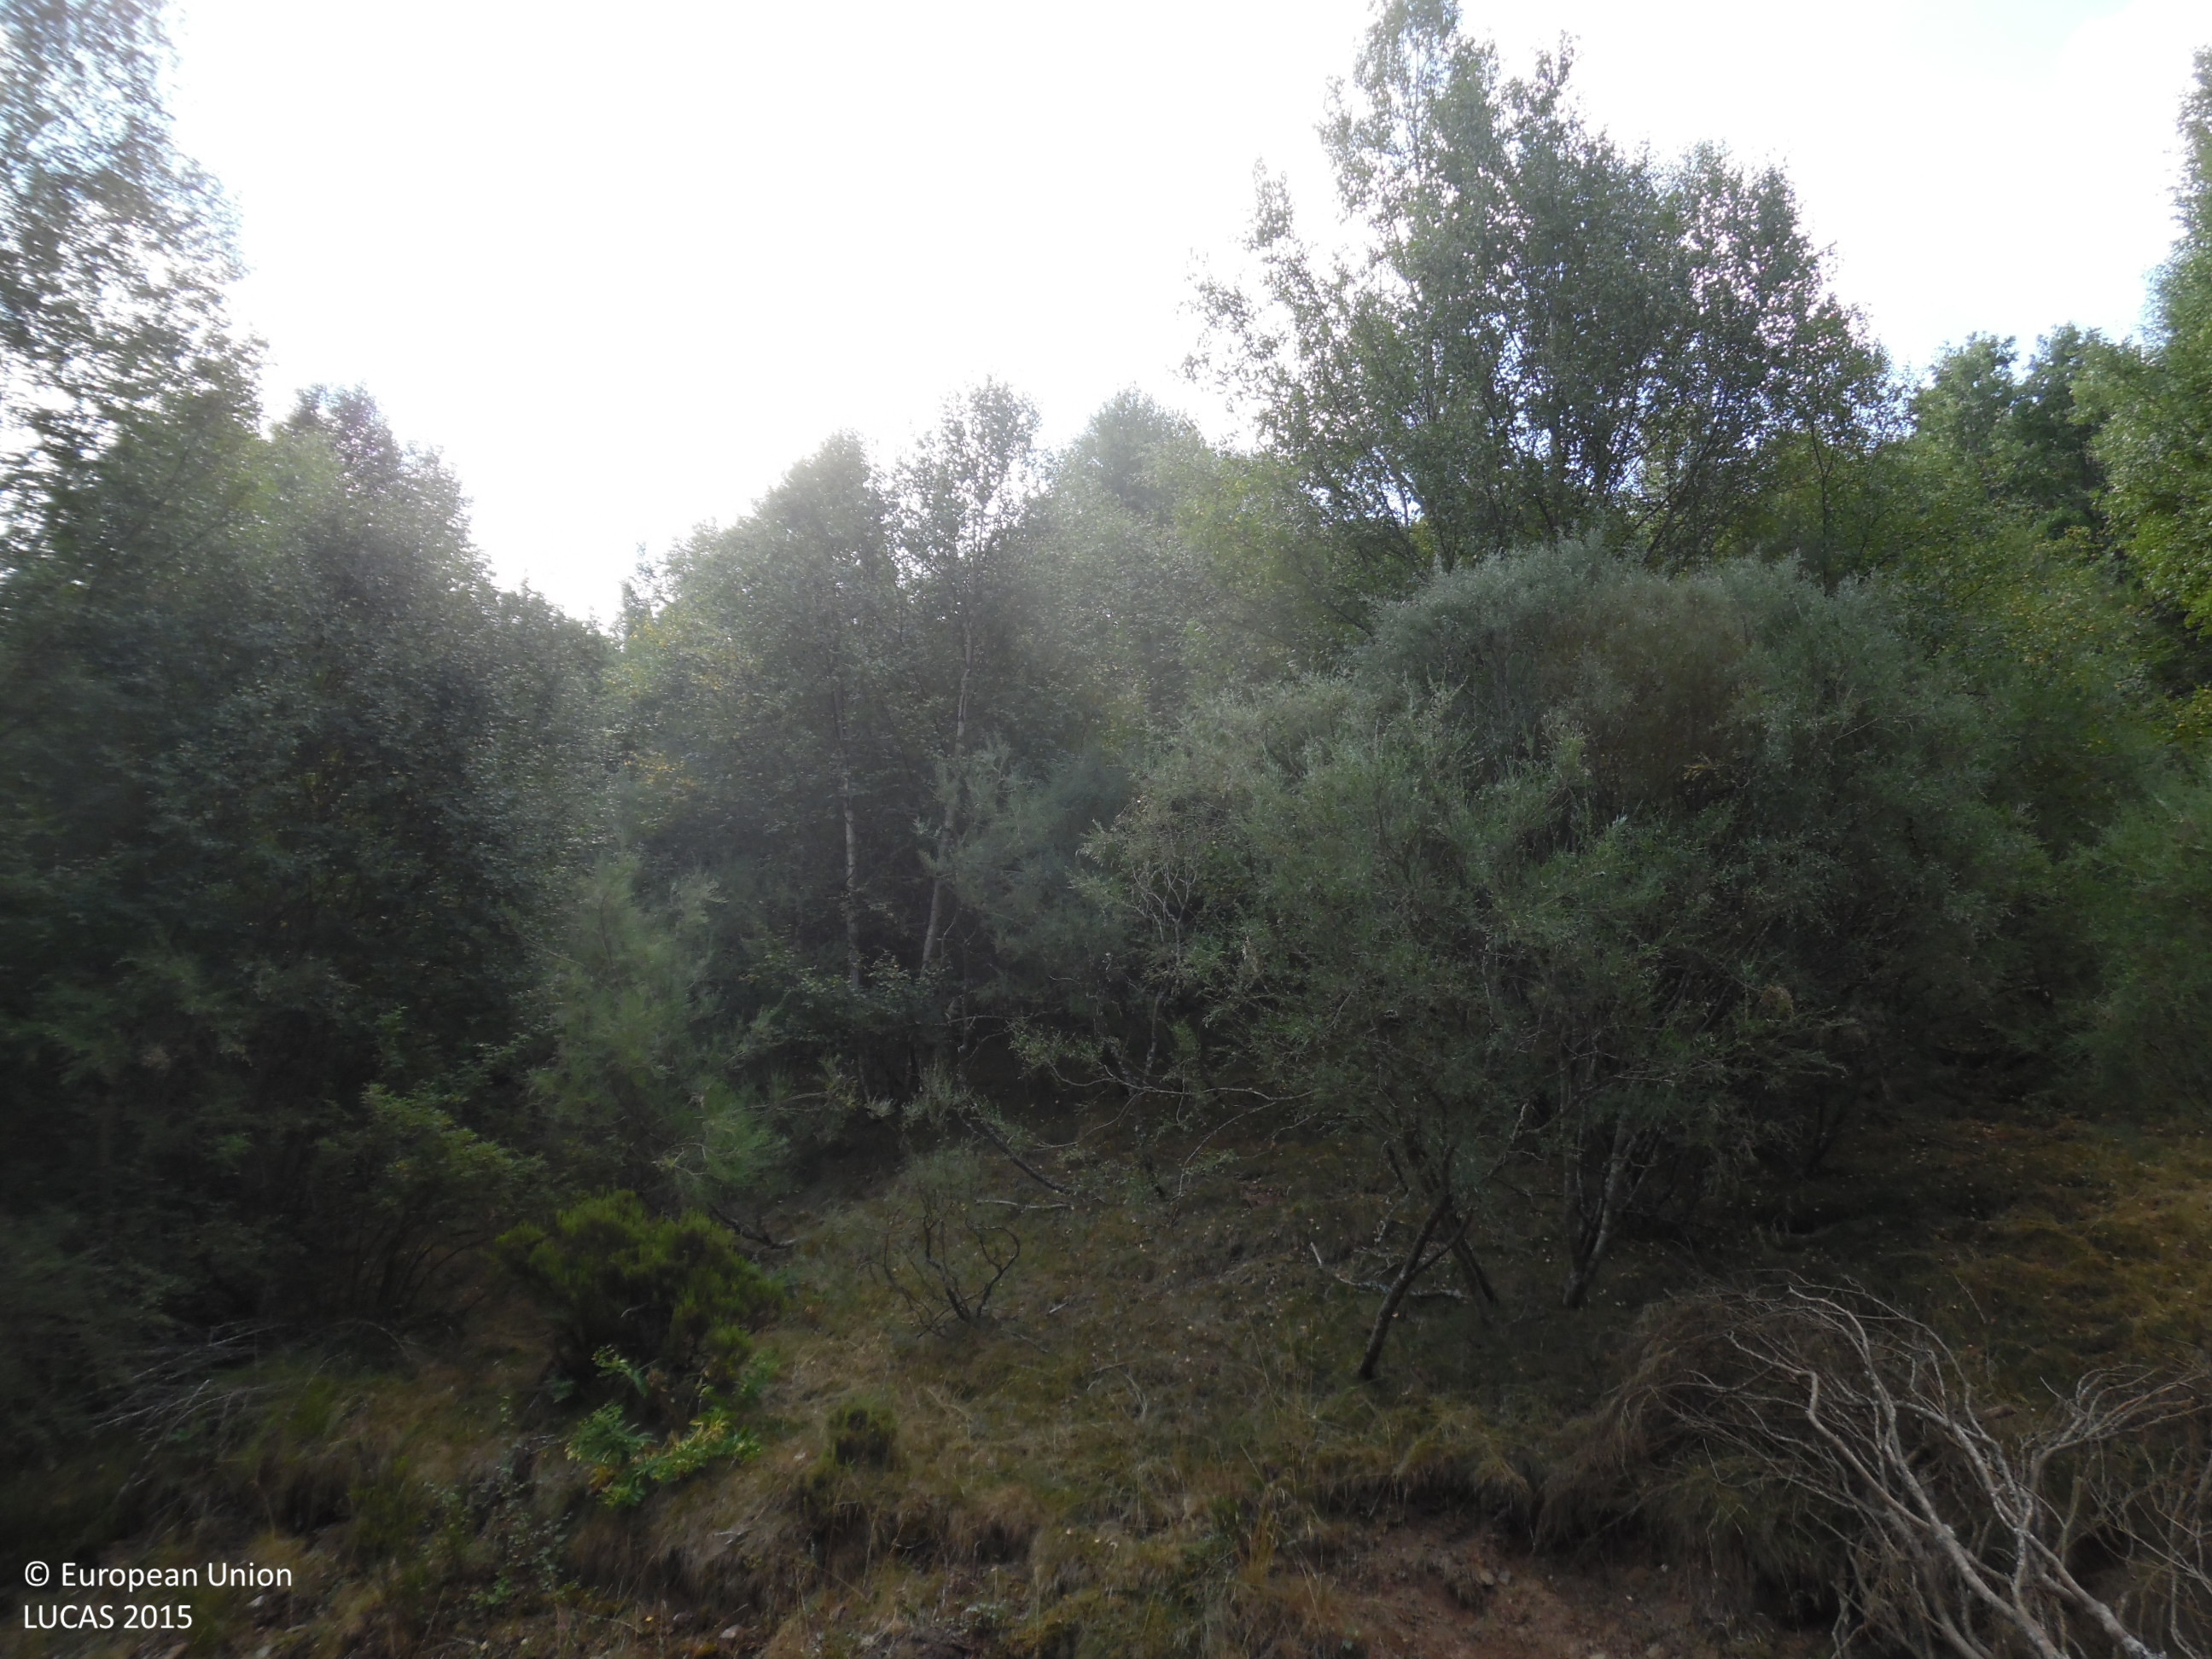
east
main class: Woodland
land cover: Broadleaved woodland
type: thermophilous deciduous forest
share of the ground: > 75 %
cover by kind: broadleaved forest trees 100 %
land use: Forestry
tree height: > 5 m
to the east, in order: Broadleaved woodland
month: August
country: ES
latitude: 42.8148
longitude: -6.1711
